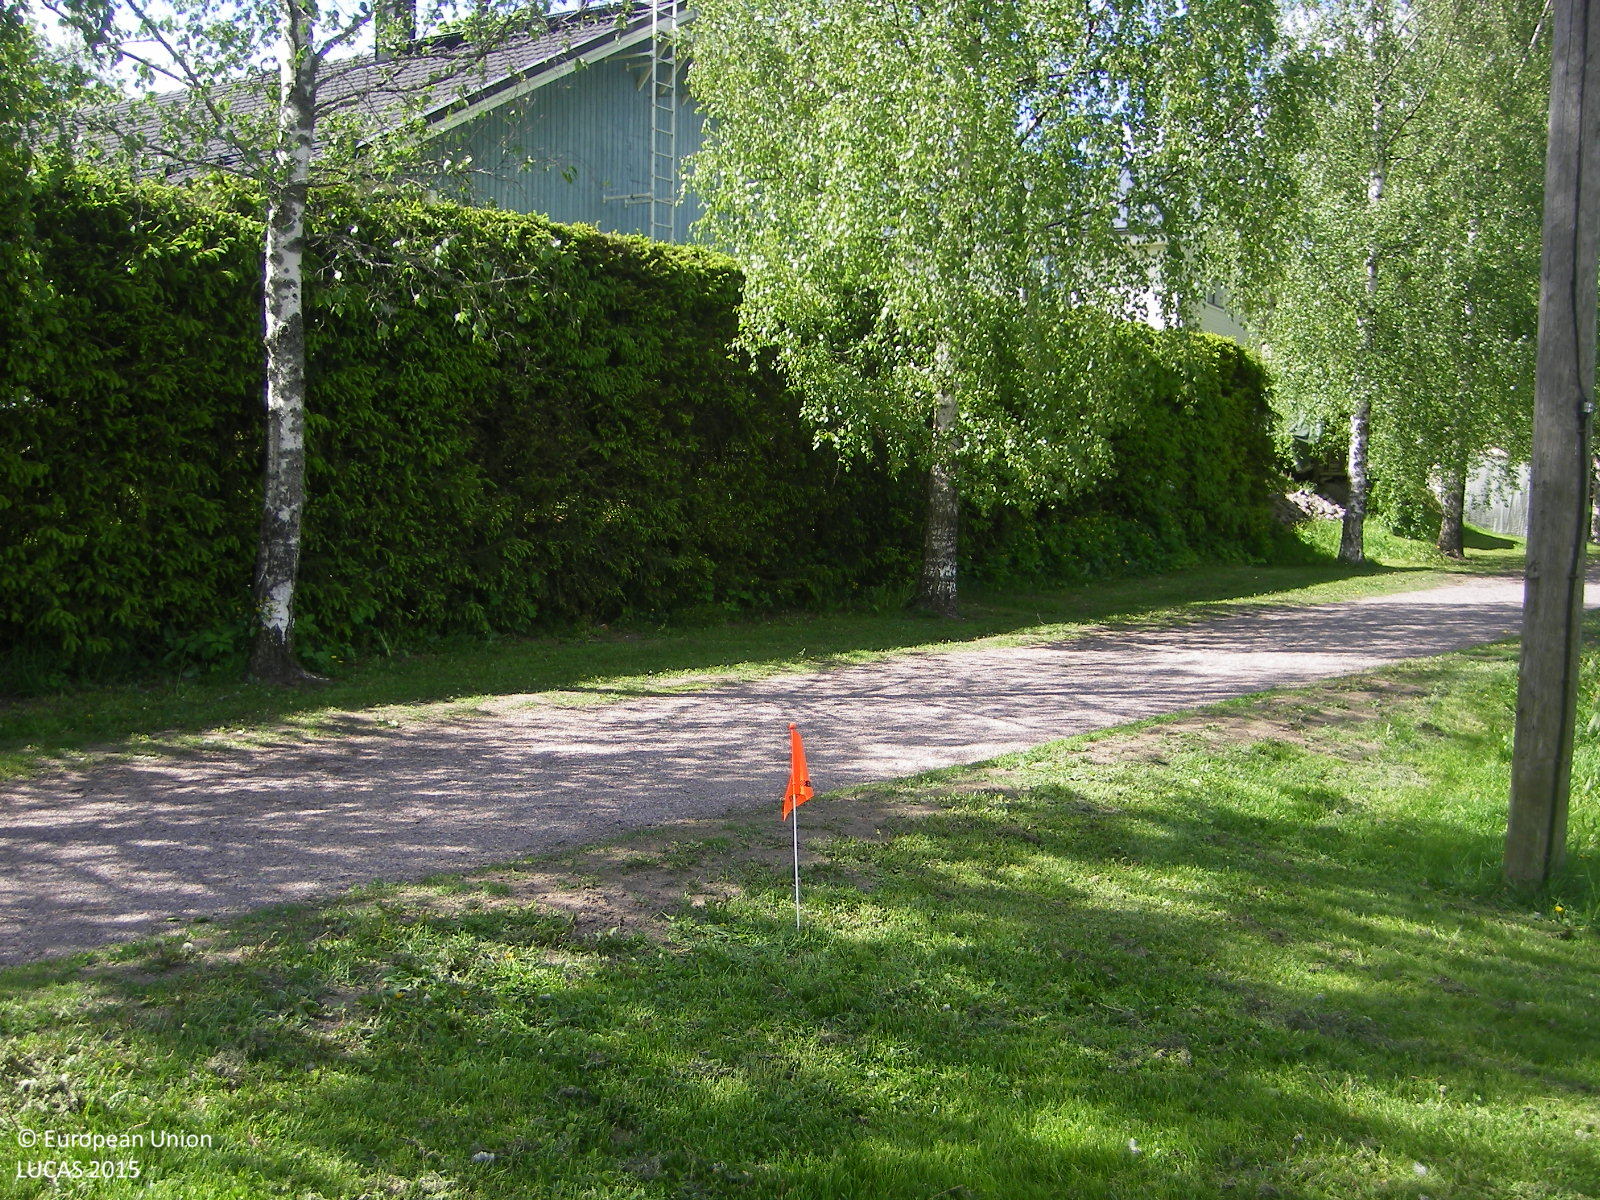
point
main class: Grassland
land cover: Grassland with sparse tree/shrub cover
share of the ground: > 75 %
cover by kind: herbaceous plants 90 %, broadleaved forest trees 5 %, shrubs 5 %
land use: Amenities, museums, leisure
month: June
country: FI
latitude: 60.2775
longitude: 24.7783
